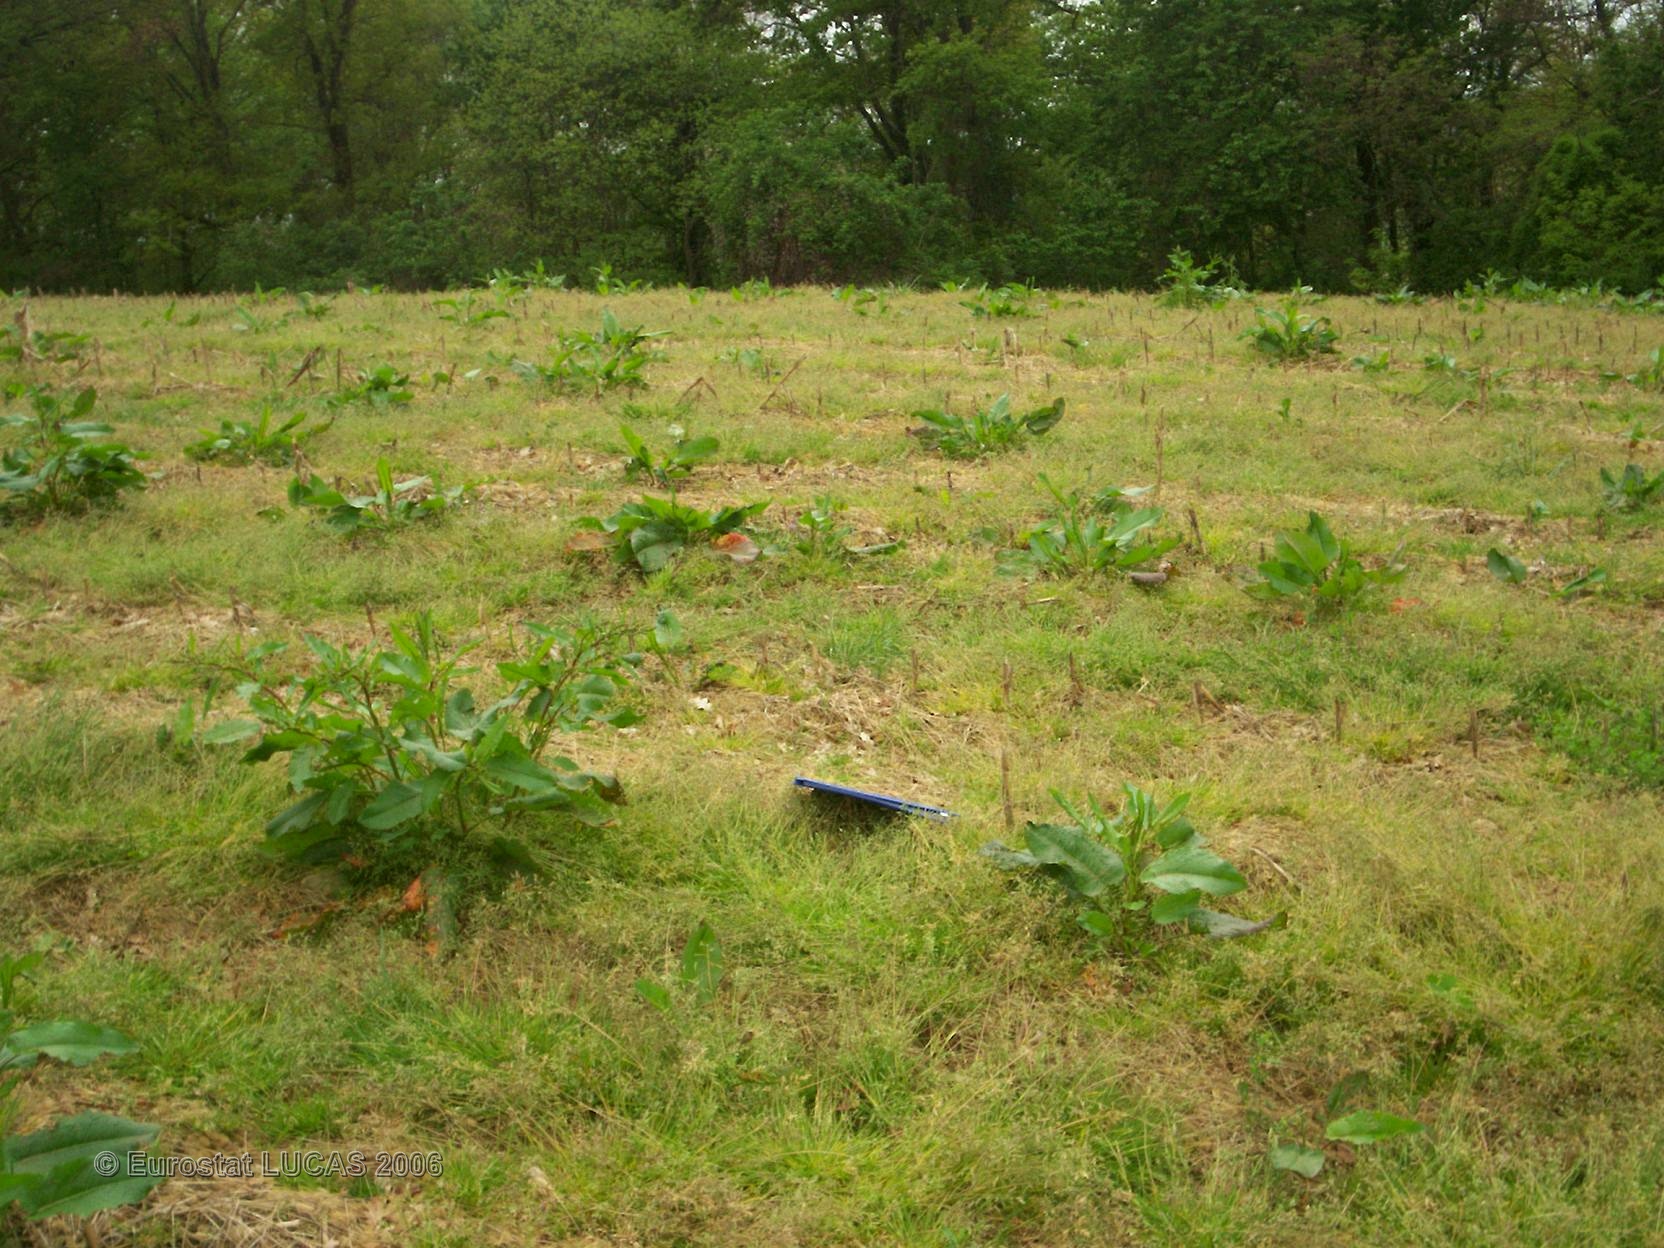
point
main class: Grassland
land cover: Grassland without tree/shrub cover
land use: Agriculture (excluding fallow land and kitchen gardens)
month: April
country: FR
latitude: 43.2622
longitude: 0.3279
